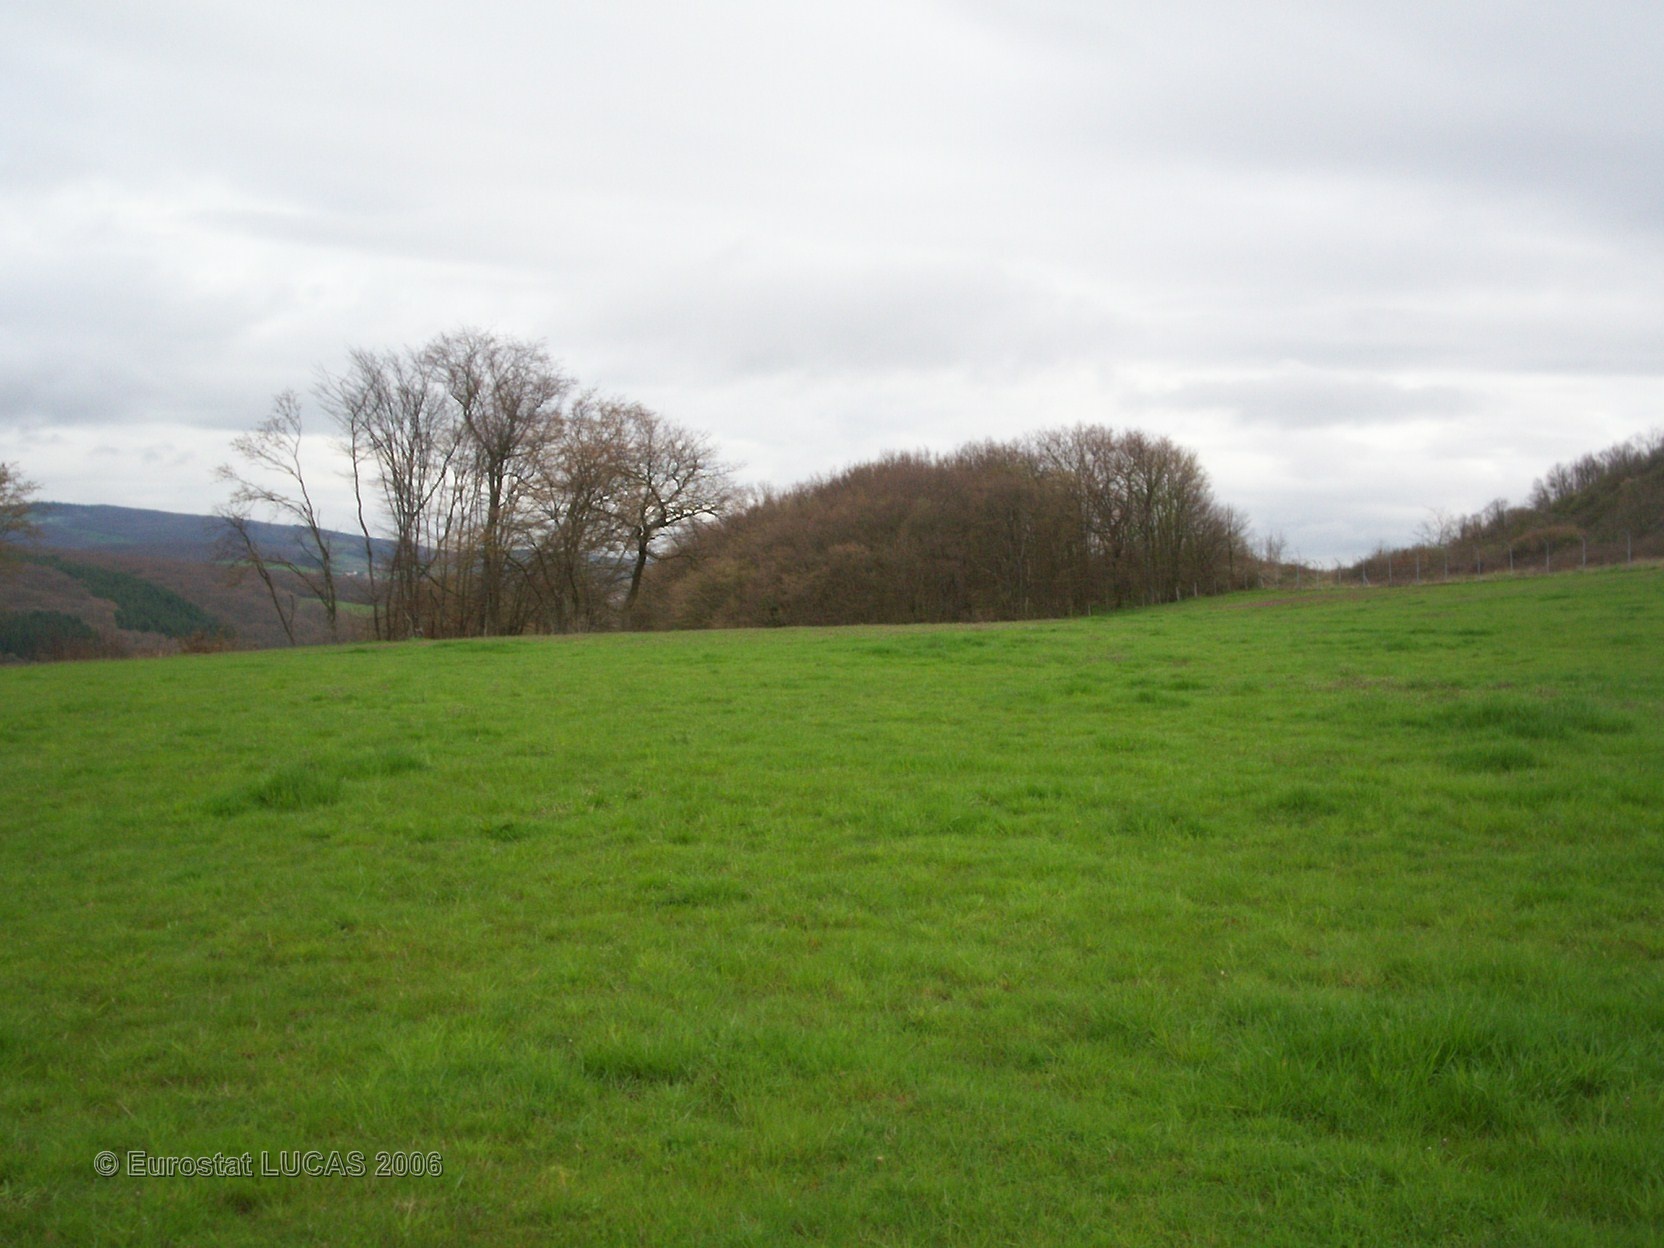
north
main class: Grassland
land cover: Grassland without tree/shrub cover
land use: Agriculture (excluding fallow land and kitchen gardens)
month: April
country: FR
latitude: 46.3982
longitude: 4.6564
